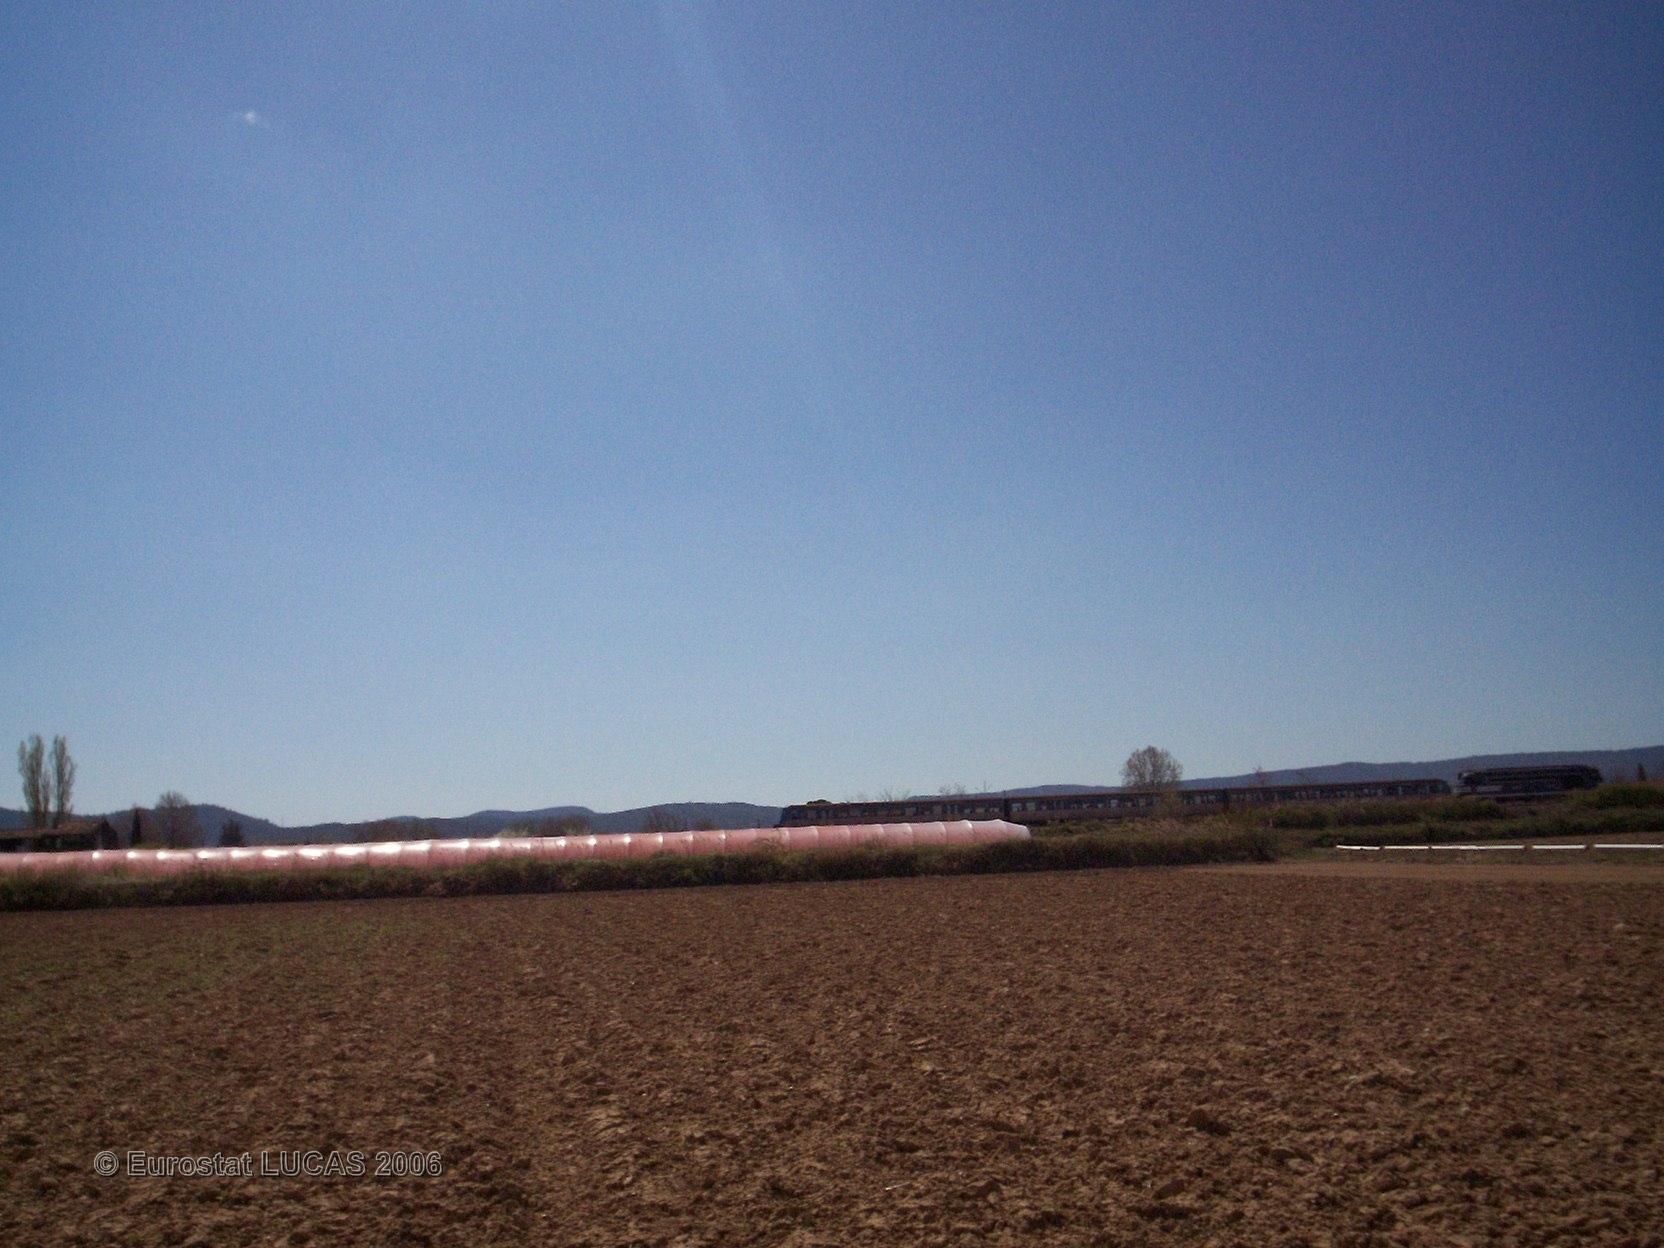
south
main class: Cropland
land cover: Maize
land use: Agriculture (excluding fallow land and kitchen gardens)
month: June
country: FR
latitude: 43.6762
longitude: 5.5315
